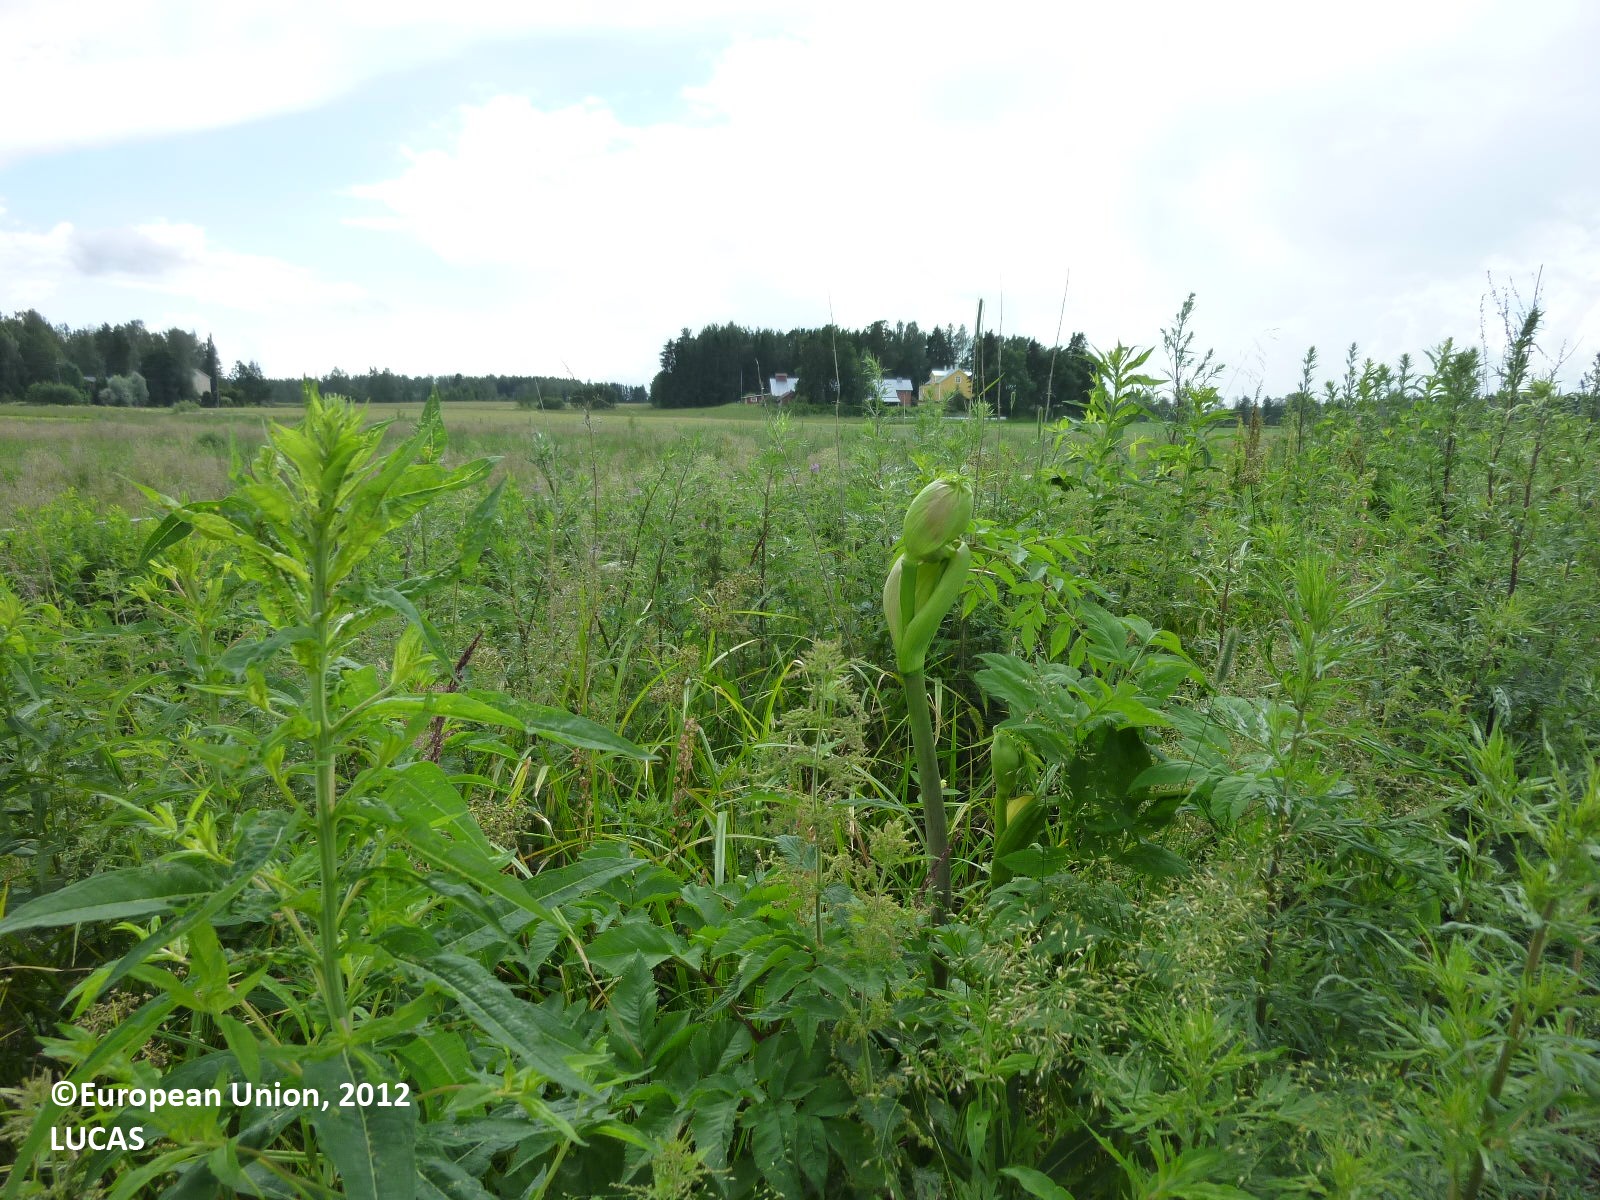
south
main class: Cropland
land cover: Oats
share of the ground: > 75 %
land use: Agriculture (excluding fallow land and kitchen gardens)
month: July
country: FI
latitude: 61.2325
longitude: 22.0361
